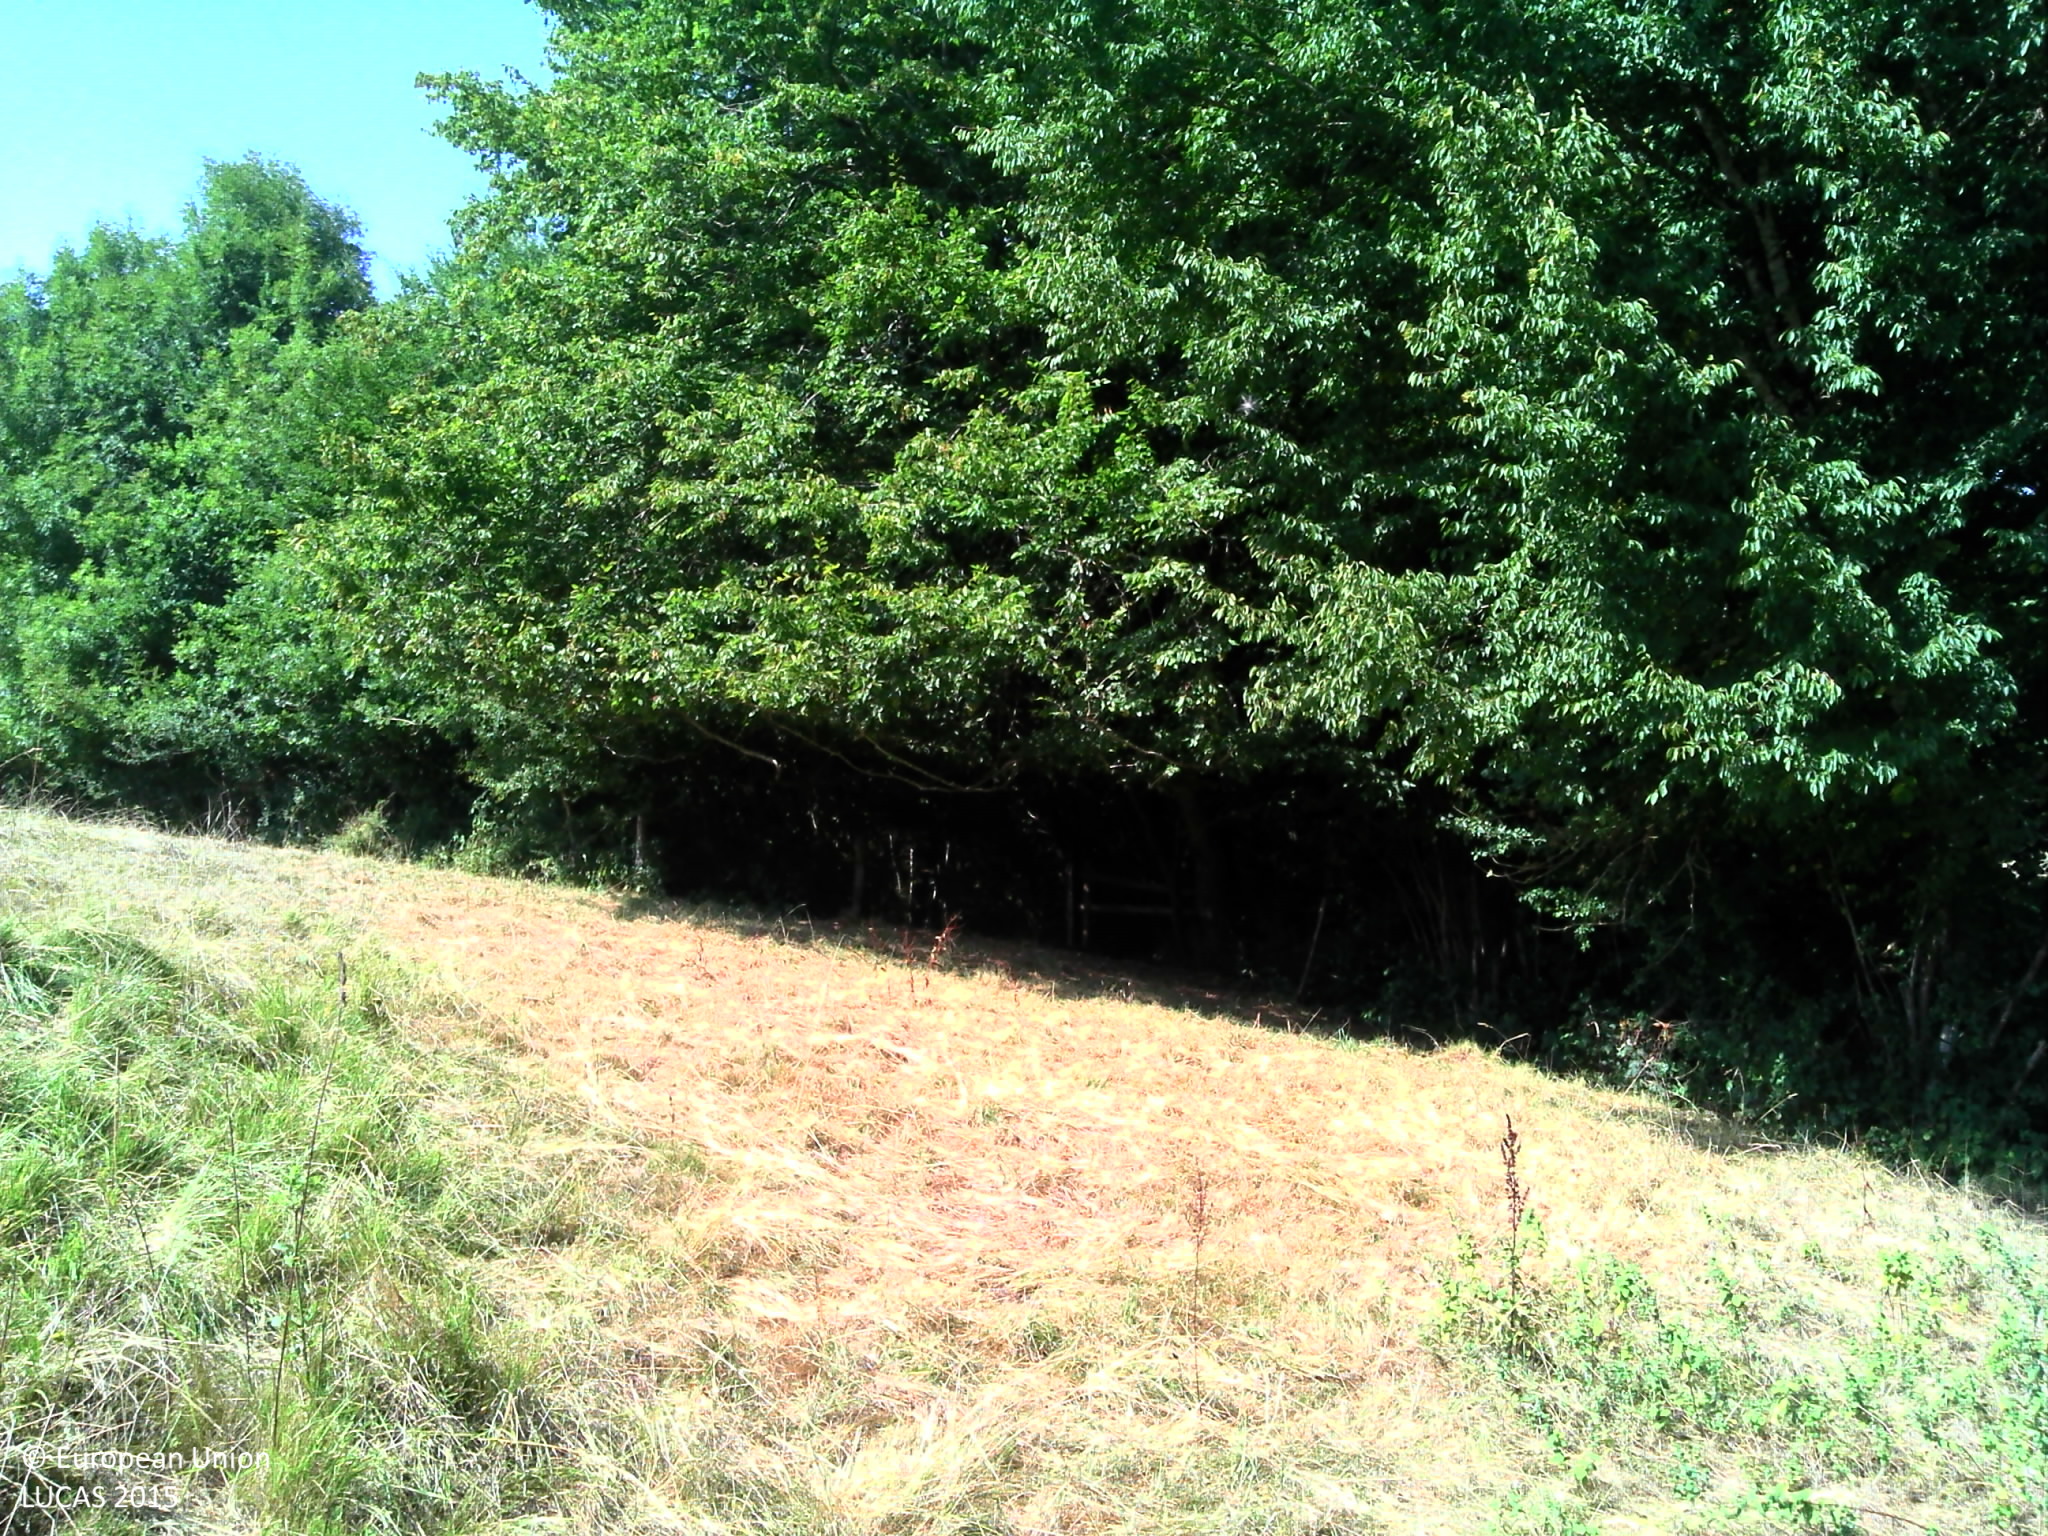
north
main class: Grassland
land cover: Grassland without tree/shrub cover
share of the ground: > 75 %
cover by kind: herbaceous plants 100 %
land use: Agriculture (excluding fallow land and kitchen gardens)
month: August
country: FR
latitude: 45.3987
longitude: 1.0876
